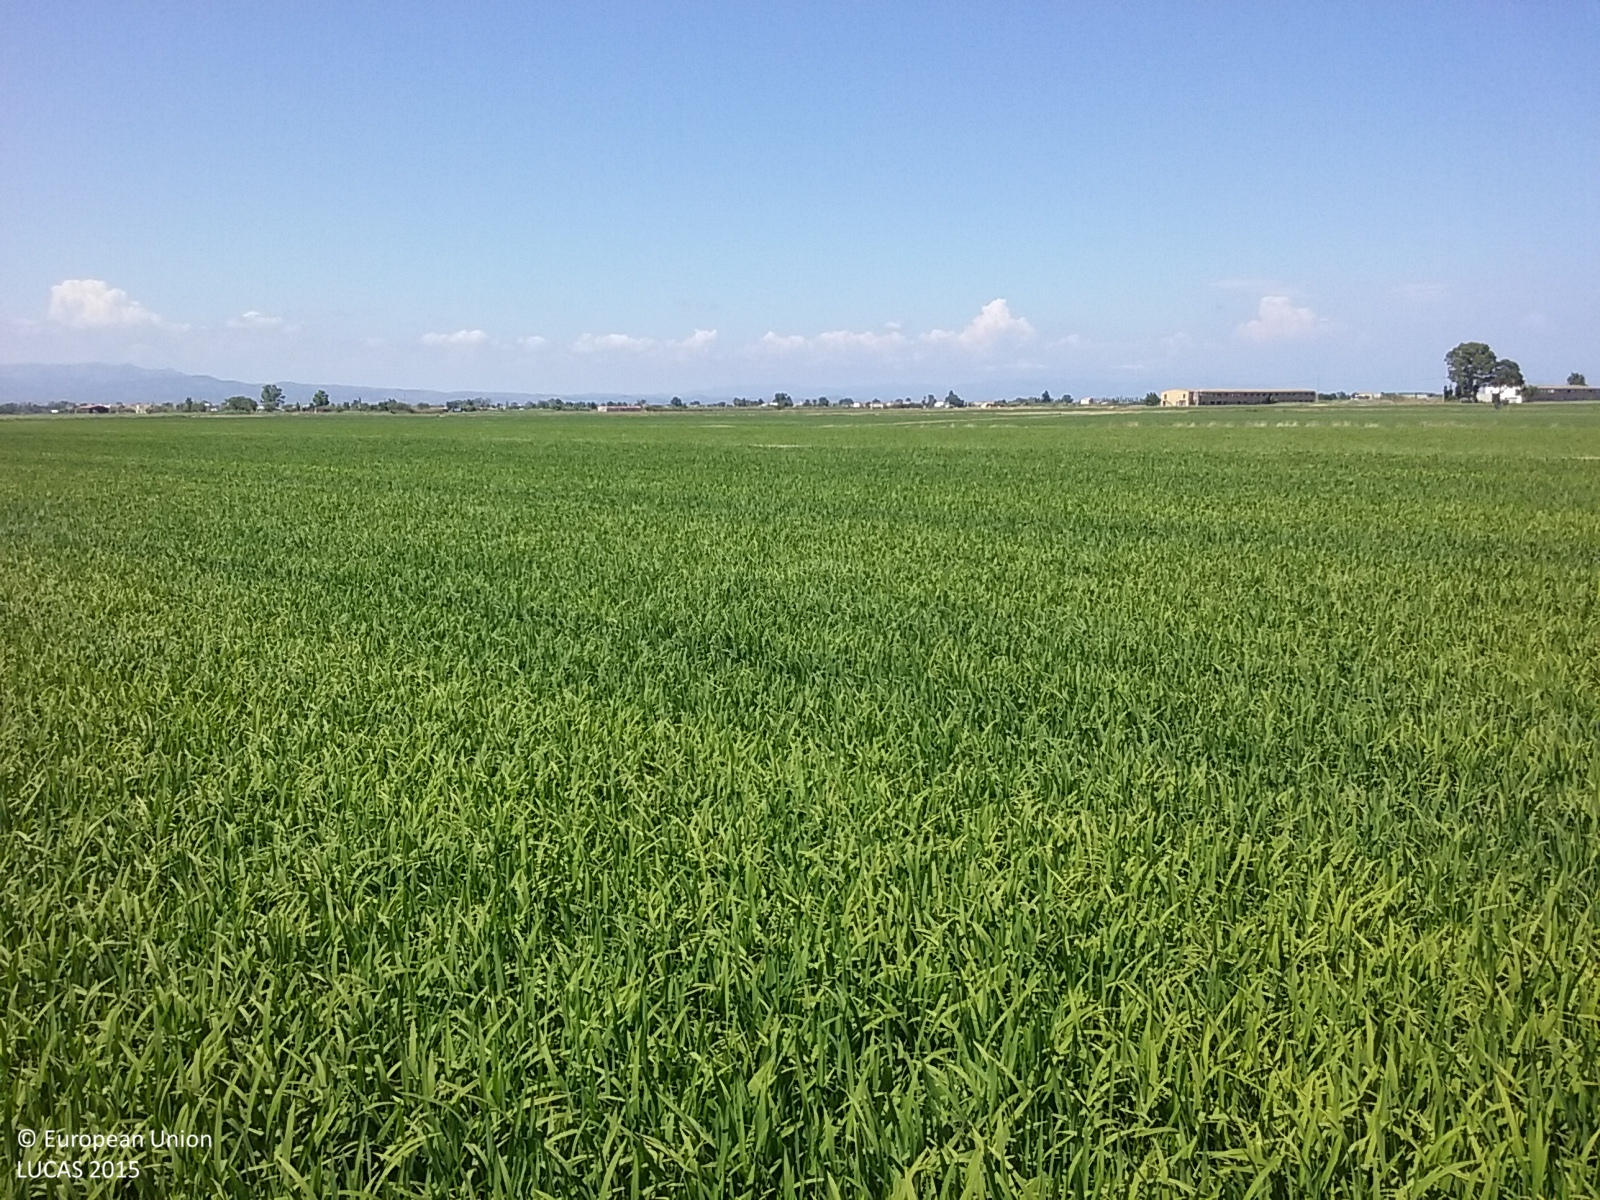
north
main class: Cropland
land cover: Rice
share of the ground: > 75 %
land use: Agriculture (excluding fallow land and kitchen gardens)
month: June
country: ES
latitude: 40.6830
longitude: 0.7313
